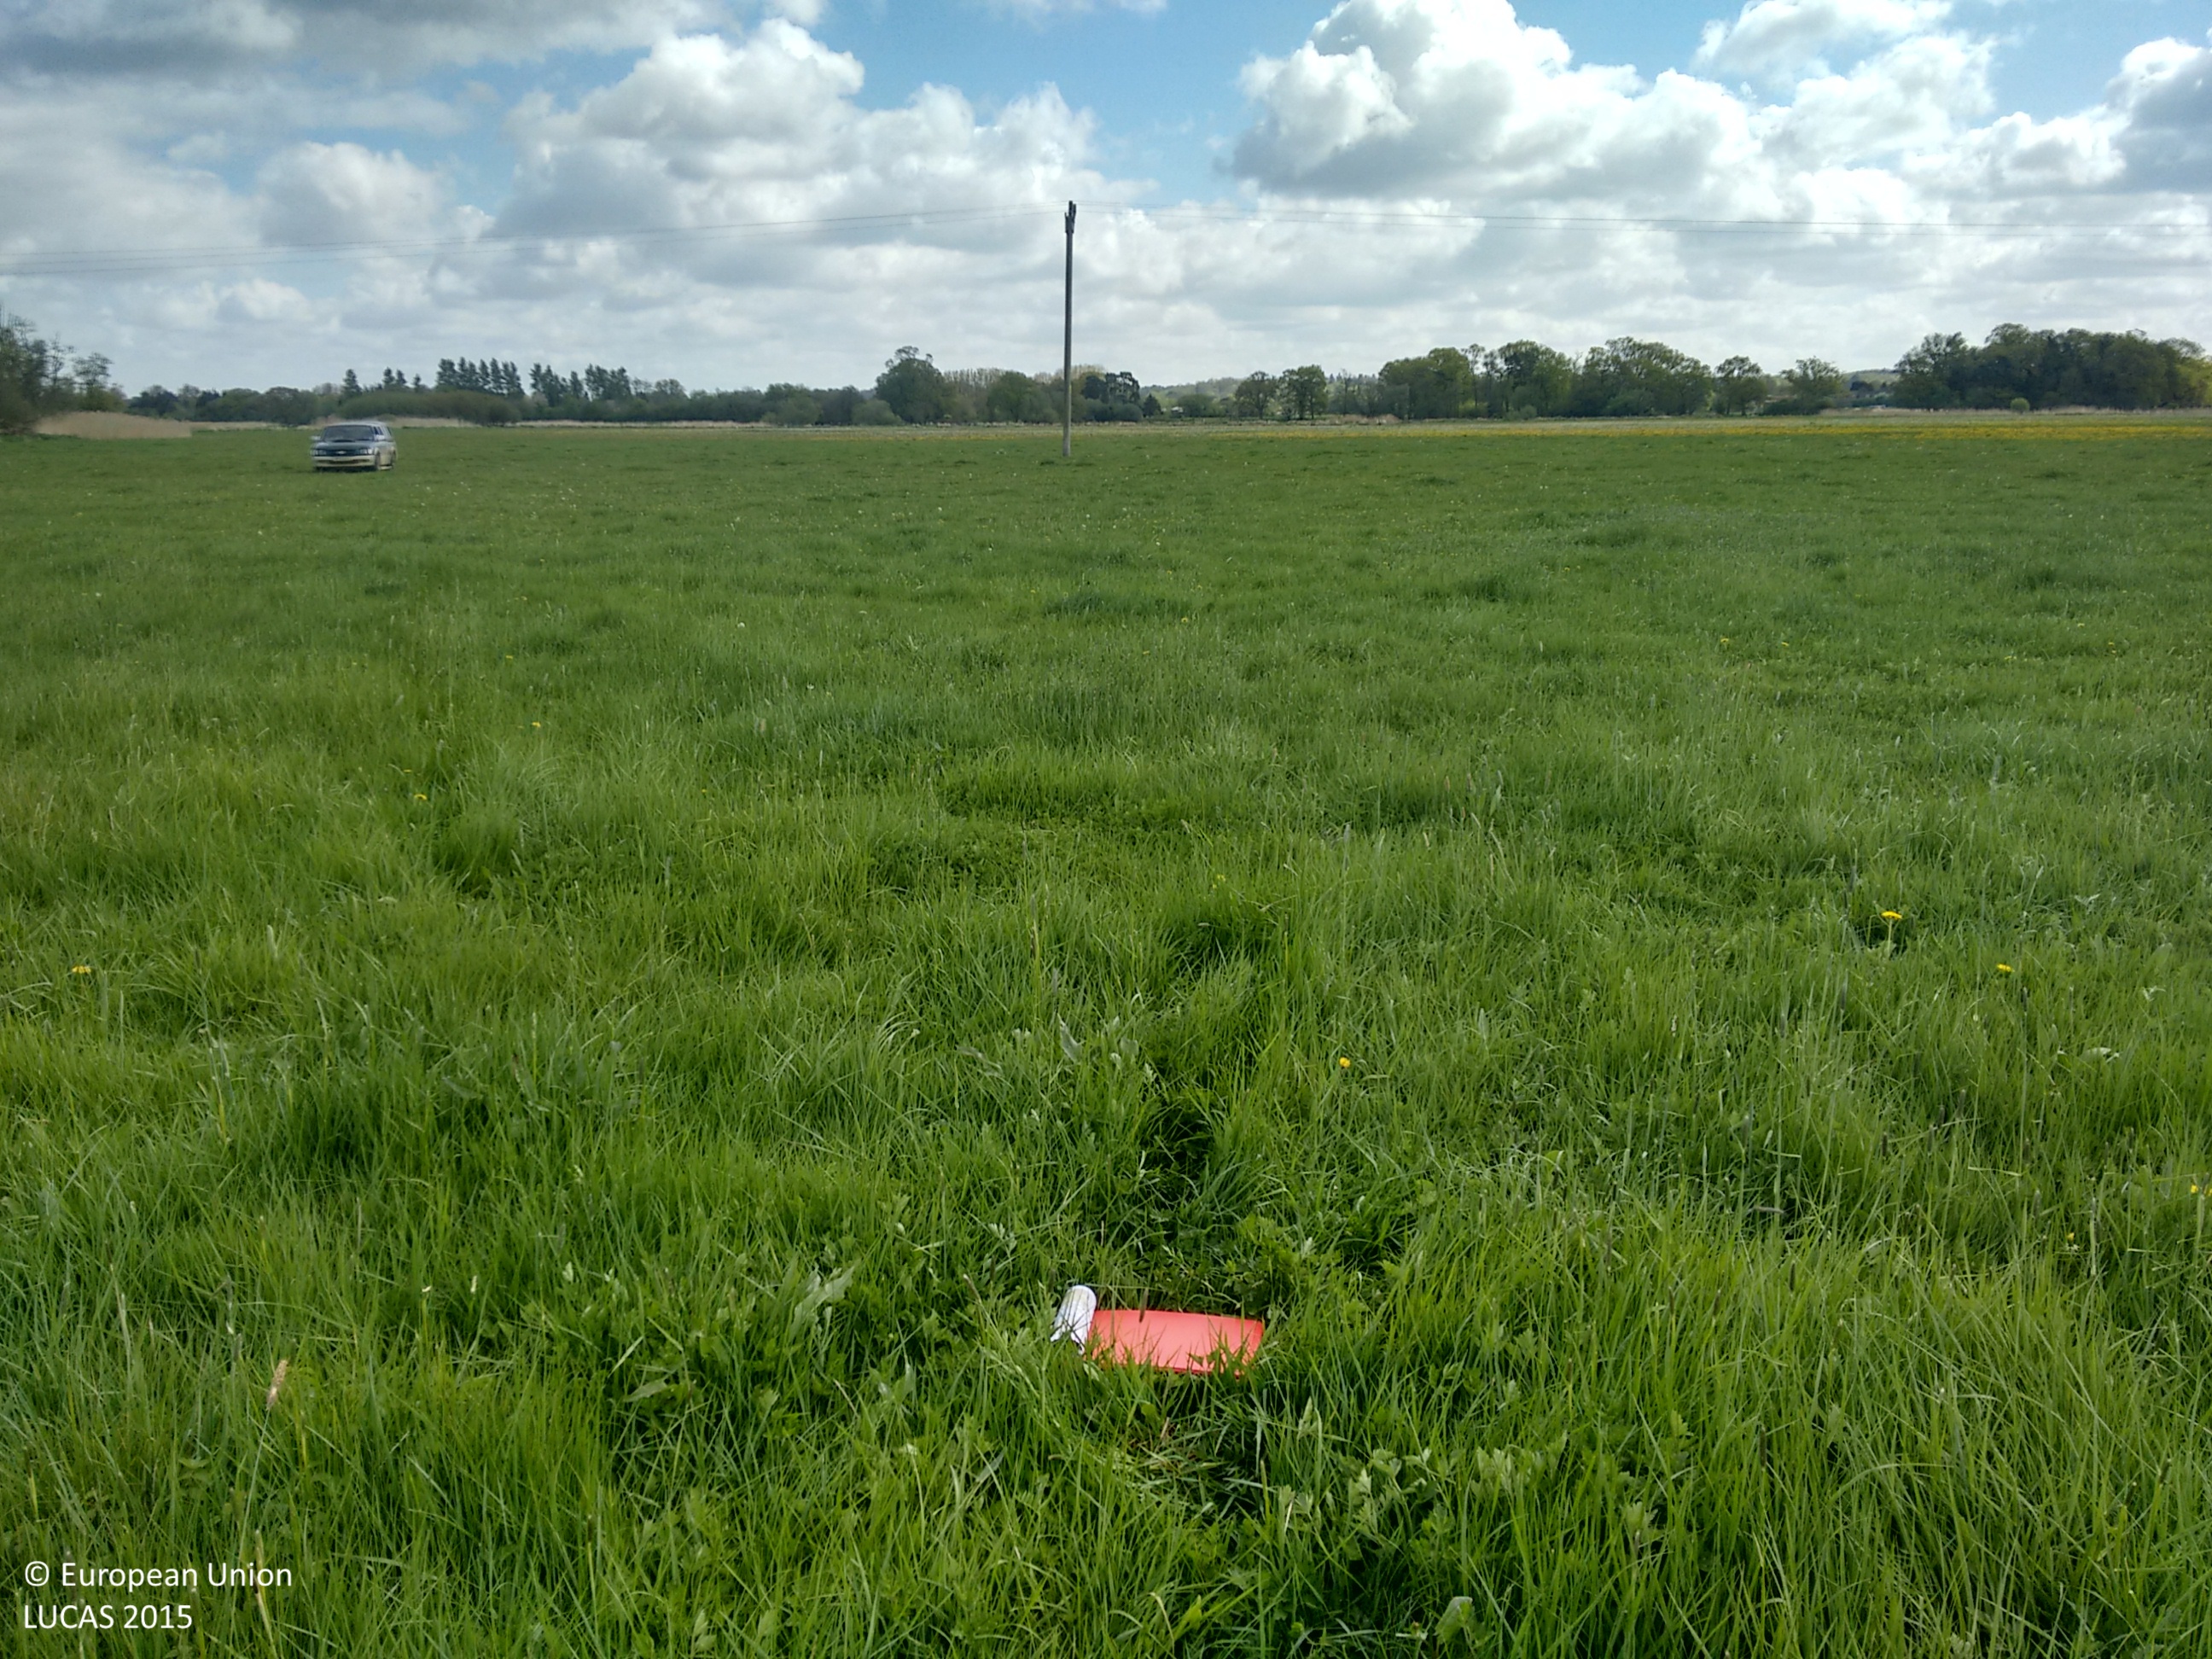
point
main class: Grassland
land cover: Grassland without tree/shrub cover
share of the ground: > 75 %
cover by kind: herbaceous plants 100 %
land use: Agriculture (excluding fallow land and kitchen gardens)
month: April
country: GB
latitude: 50.8591
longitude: -1.8042
